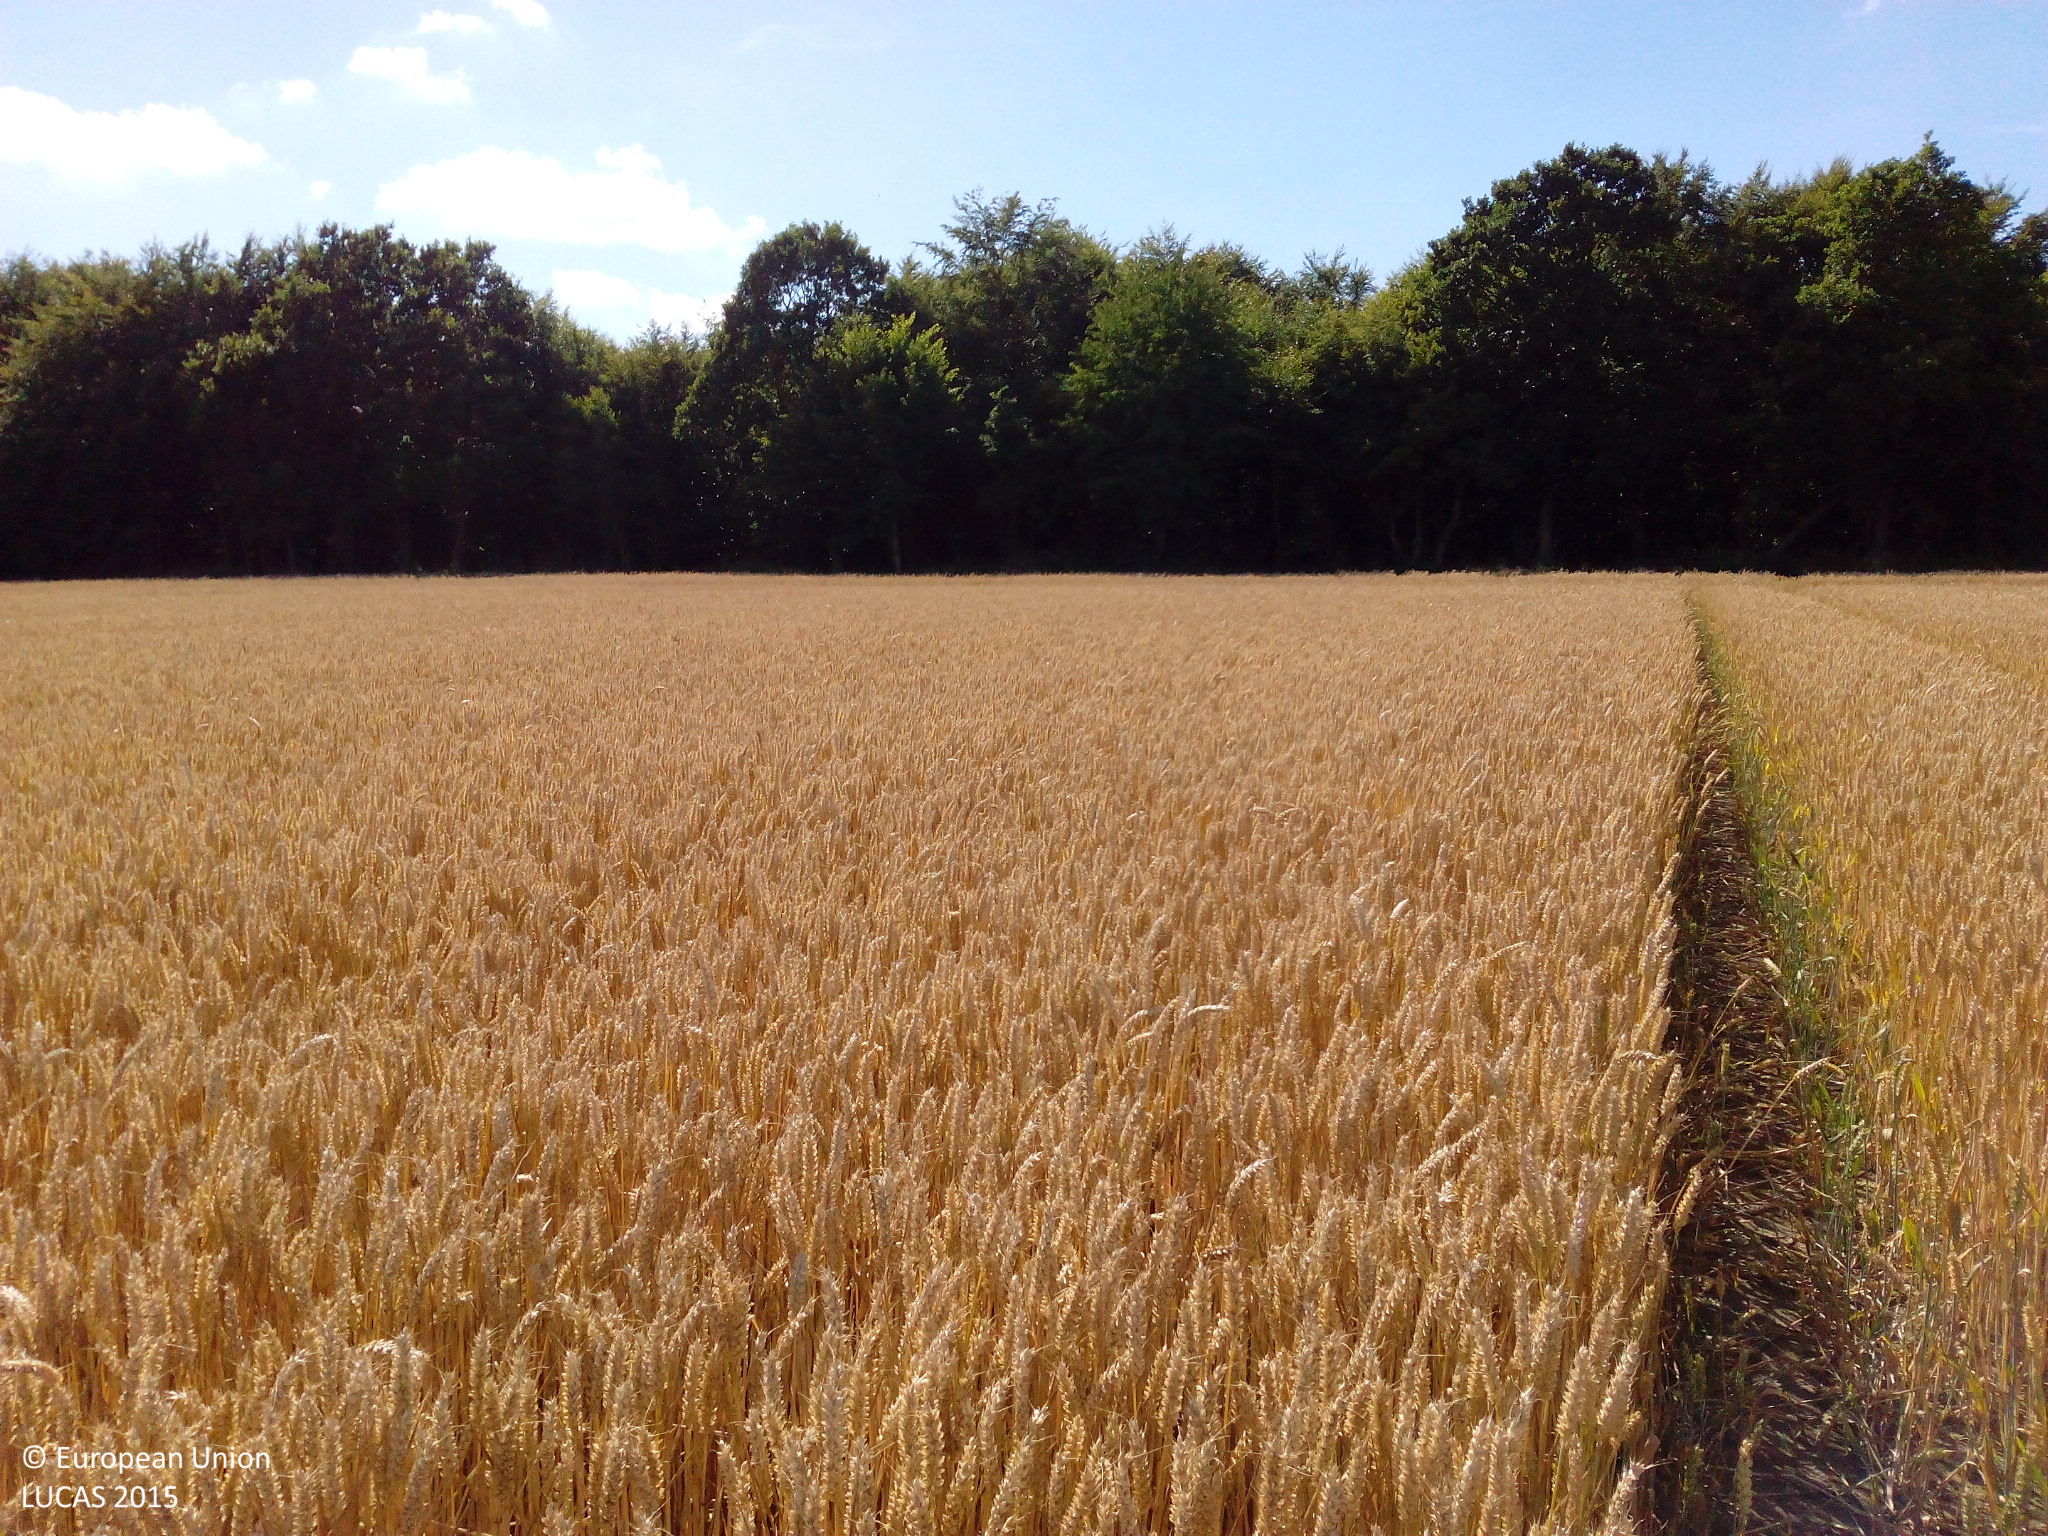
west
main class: Cropland
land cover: Common wheat
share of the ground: > 75 %
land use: Agriculture (excluding fallow land and kitchen gardens)
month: August
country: DK
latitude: 55.3060
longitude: 12.1881
